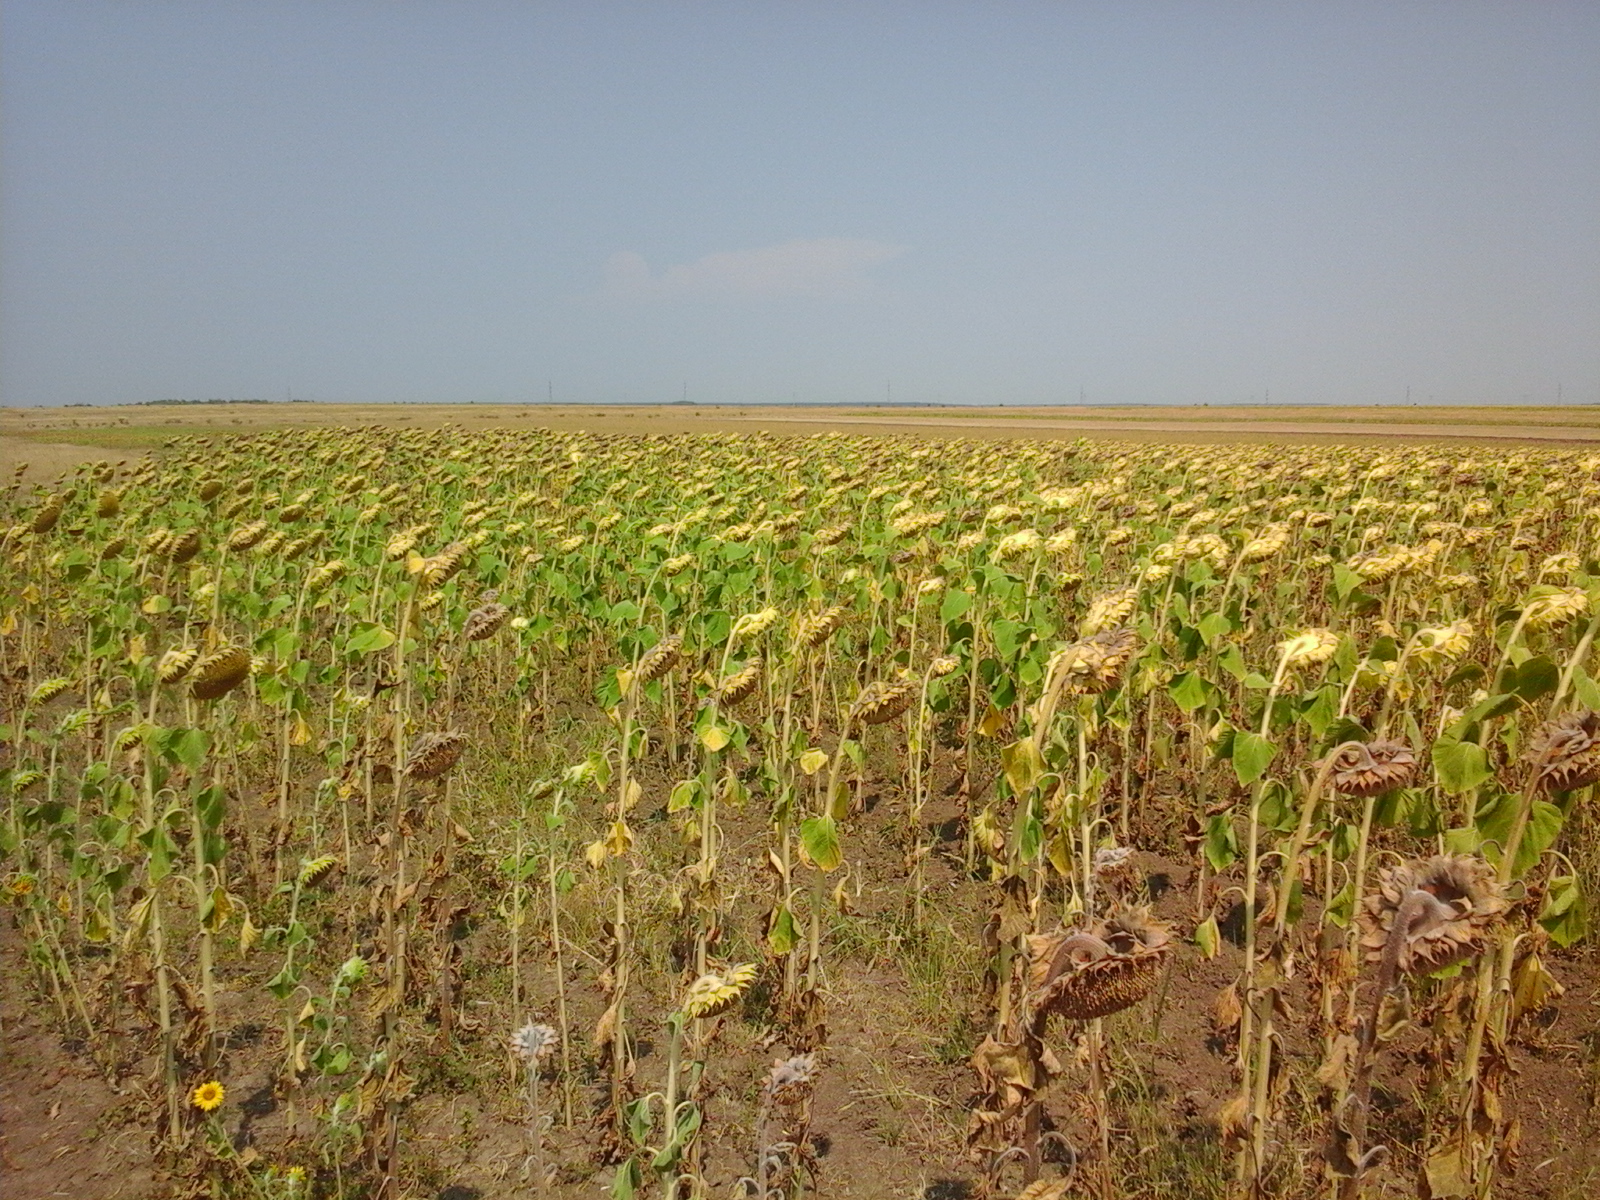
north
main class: Cropland
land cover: Sunflower
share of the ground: > 75 %
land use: Agriculture (excluding fallow land and kitchen gardens)
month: August
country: RO
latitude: 44.4866
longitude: 23.7762
